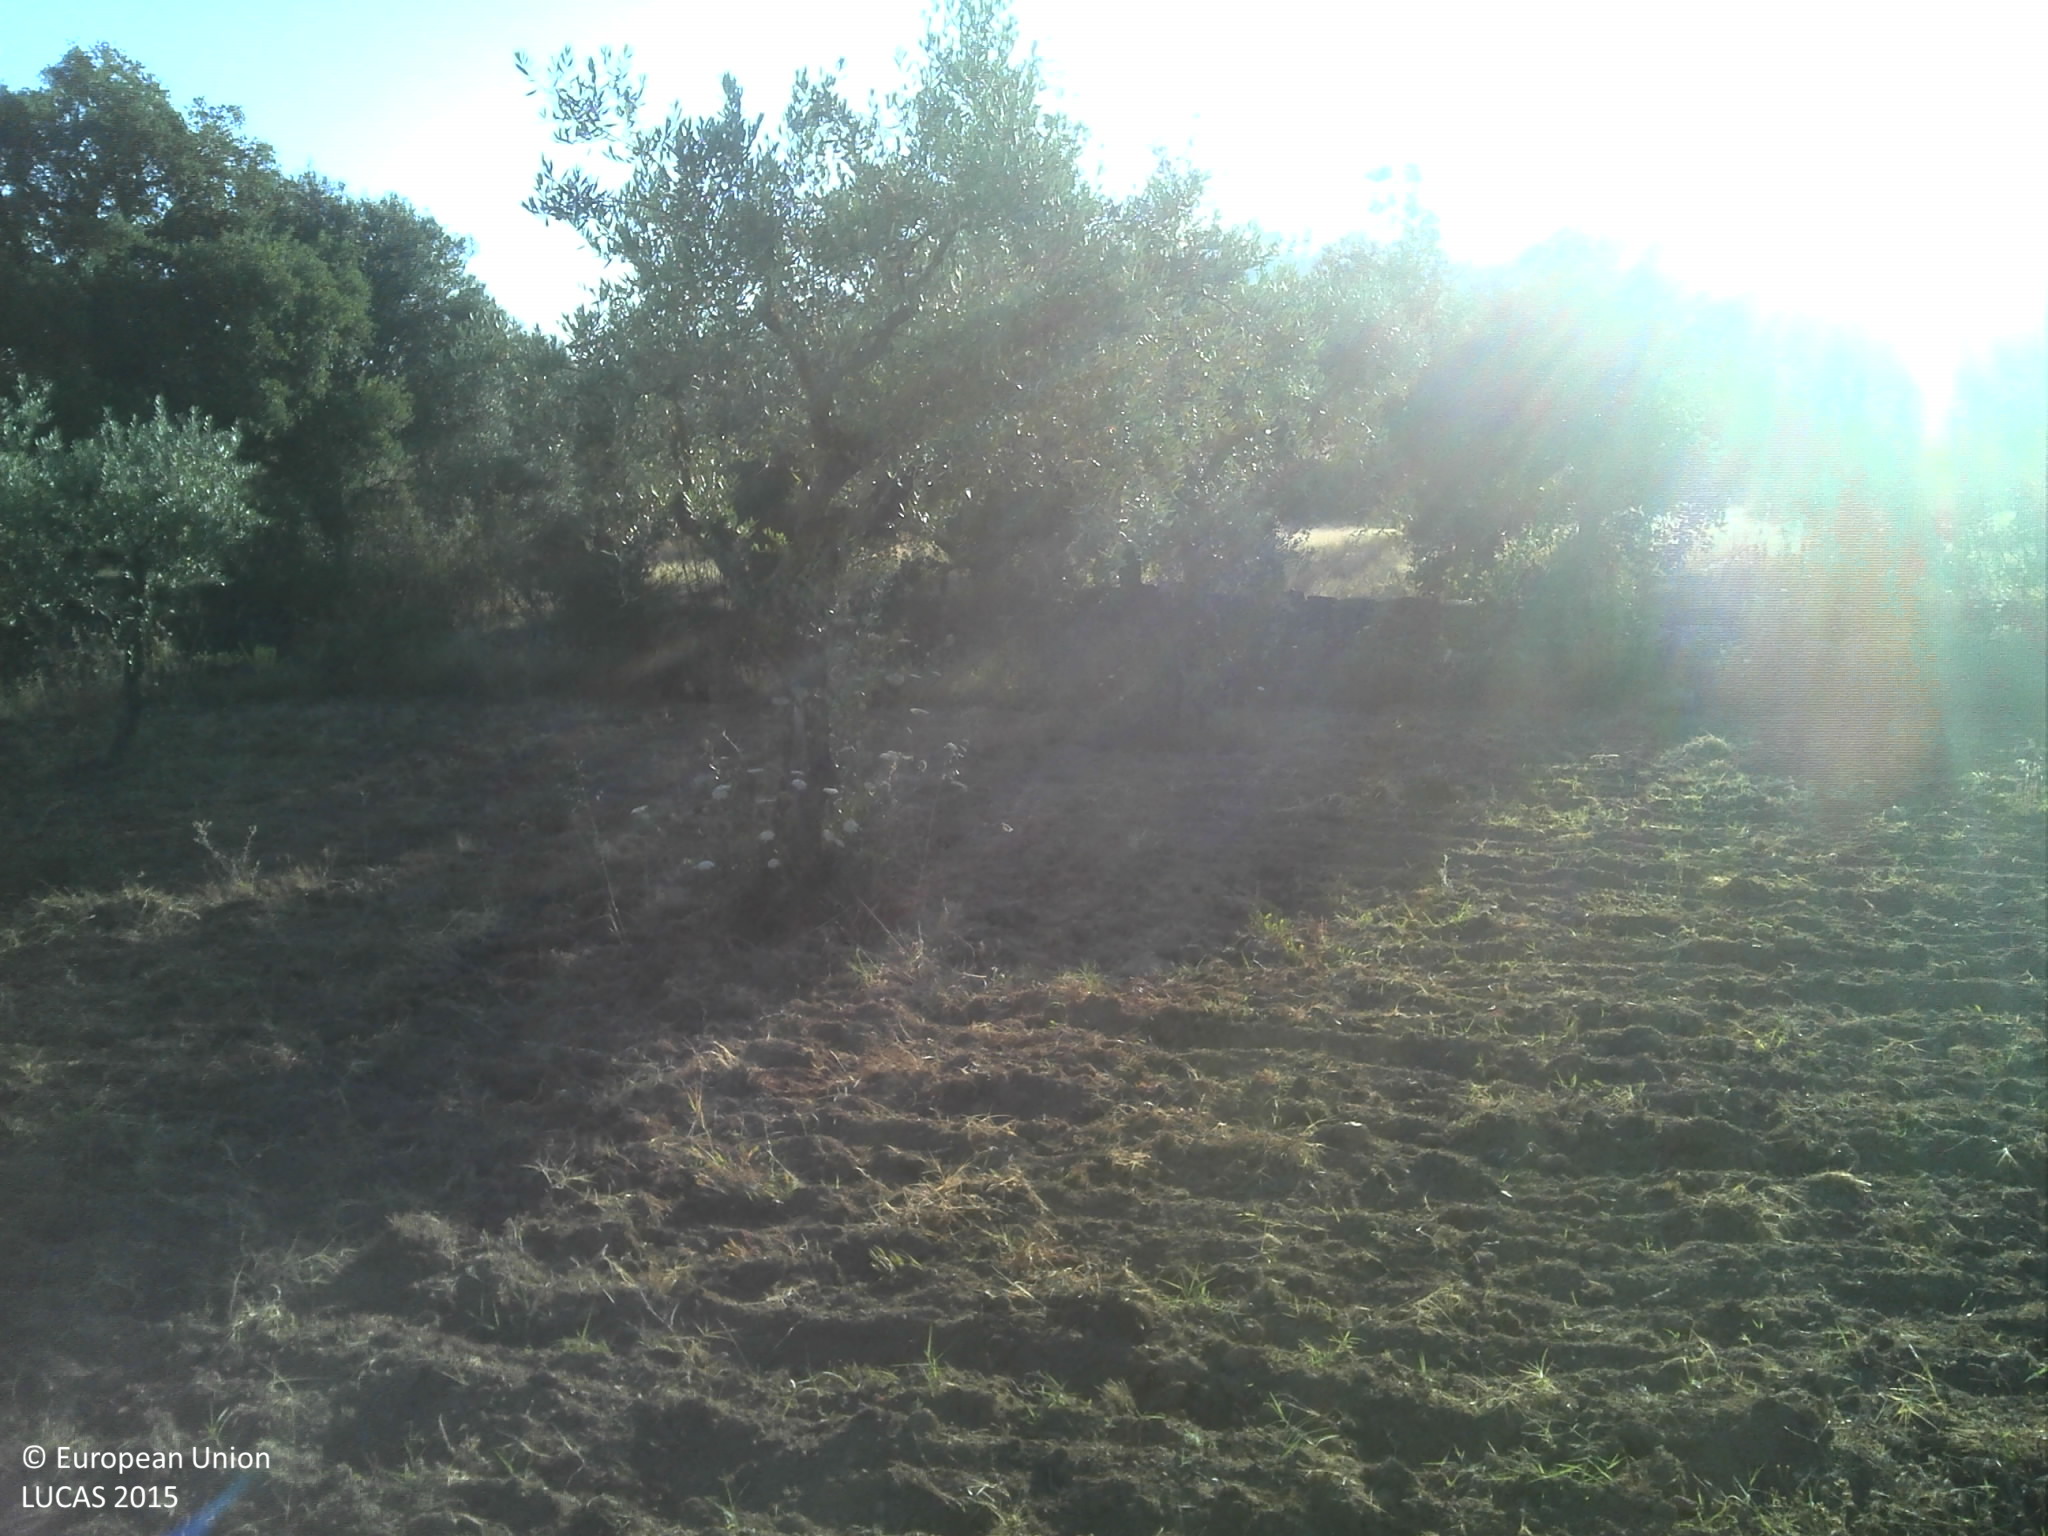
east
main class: Cropland
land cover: Olive groves
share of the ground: 25 - 50 %
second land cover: Other bare soil
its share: > 75 %
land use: Agriculture (excluding fallow land and kitchen gardens)
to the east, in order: Olive groves; Other bare soil; Dry stone walls; Tracks; Dry stone walls; Fences; Olive groves; Abandoned hedges; Olive groves; Abandoned hedges; Olive groves; Shrubland with sparse tree cover; Artificial constructions in urban areas; Shrubland with sparse tree cover
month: June
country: PT
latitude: 39.9229
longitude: -7.5710
